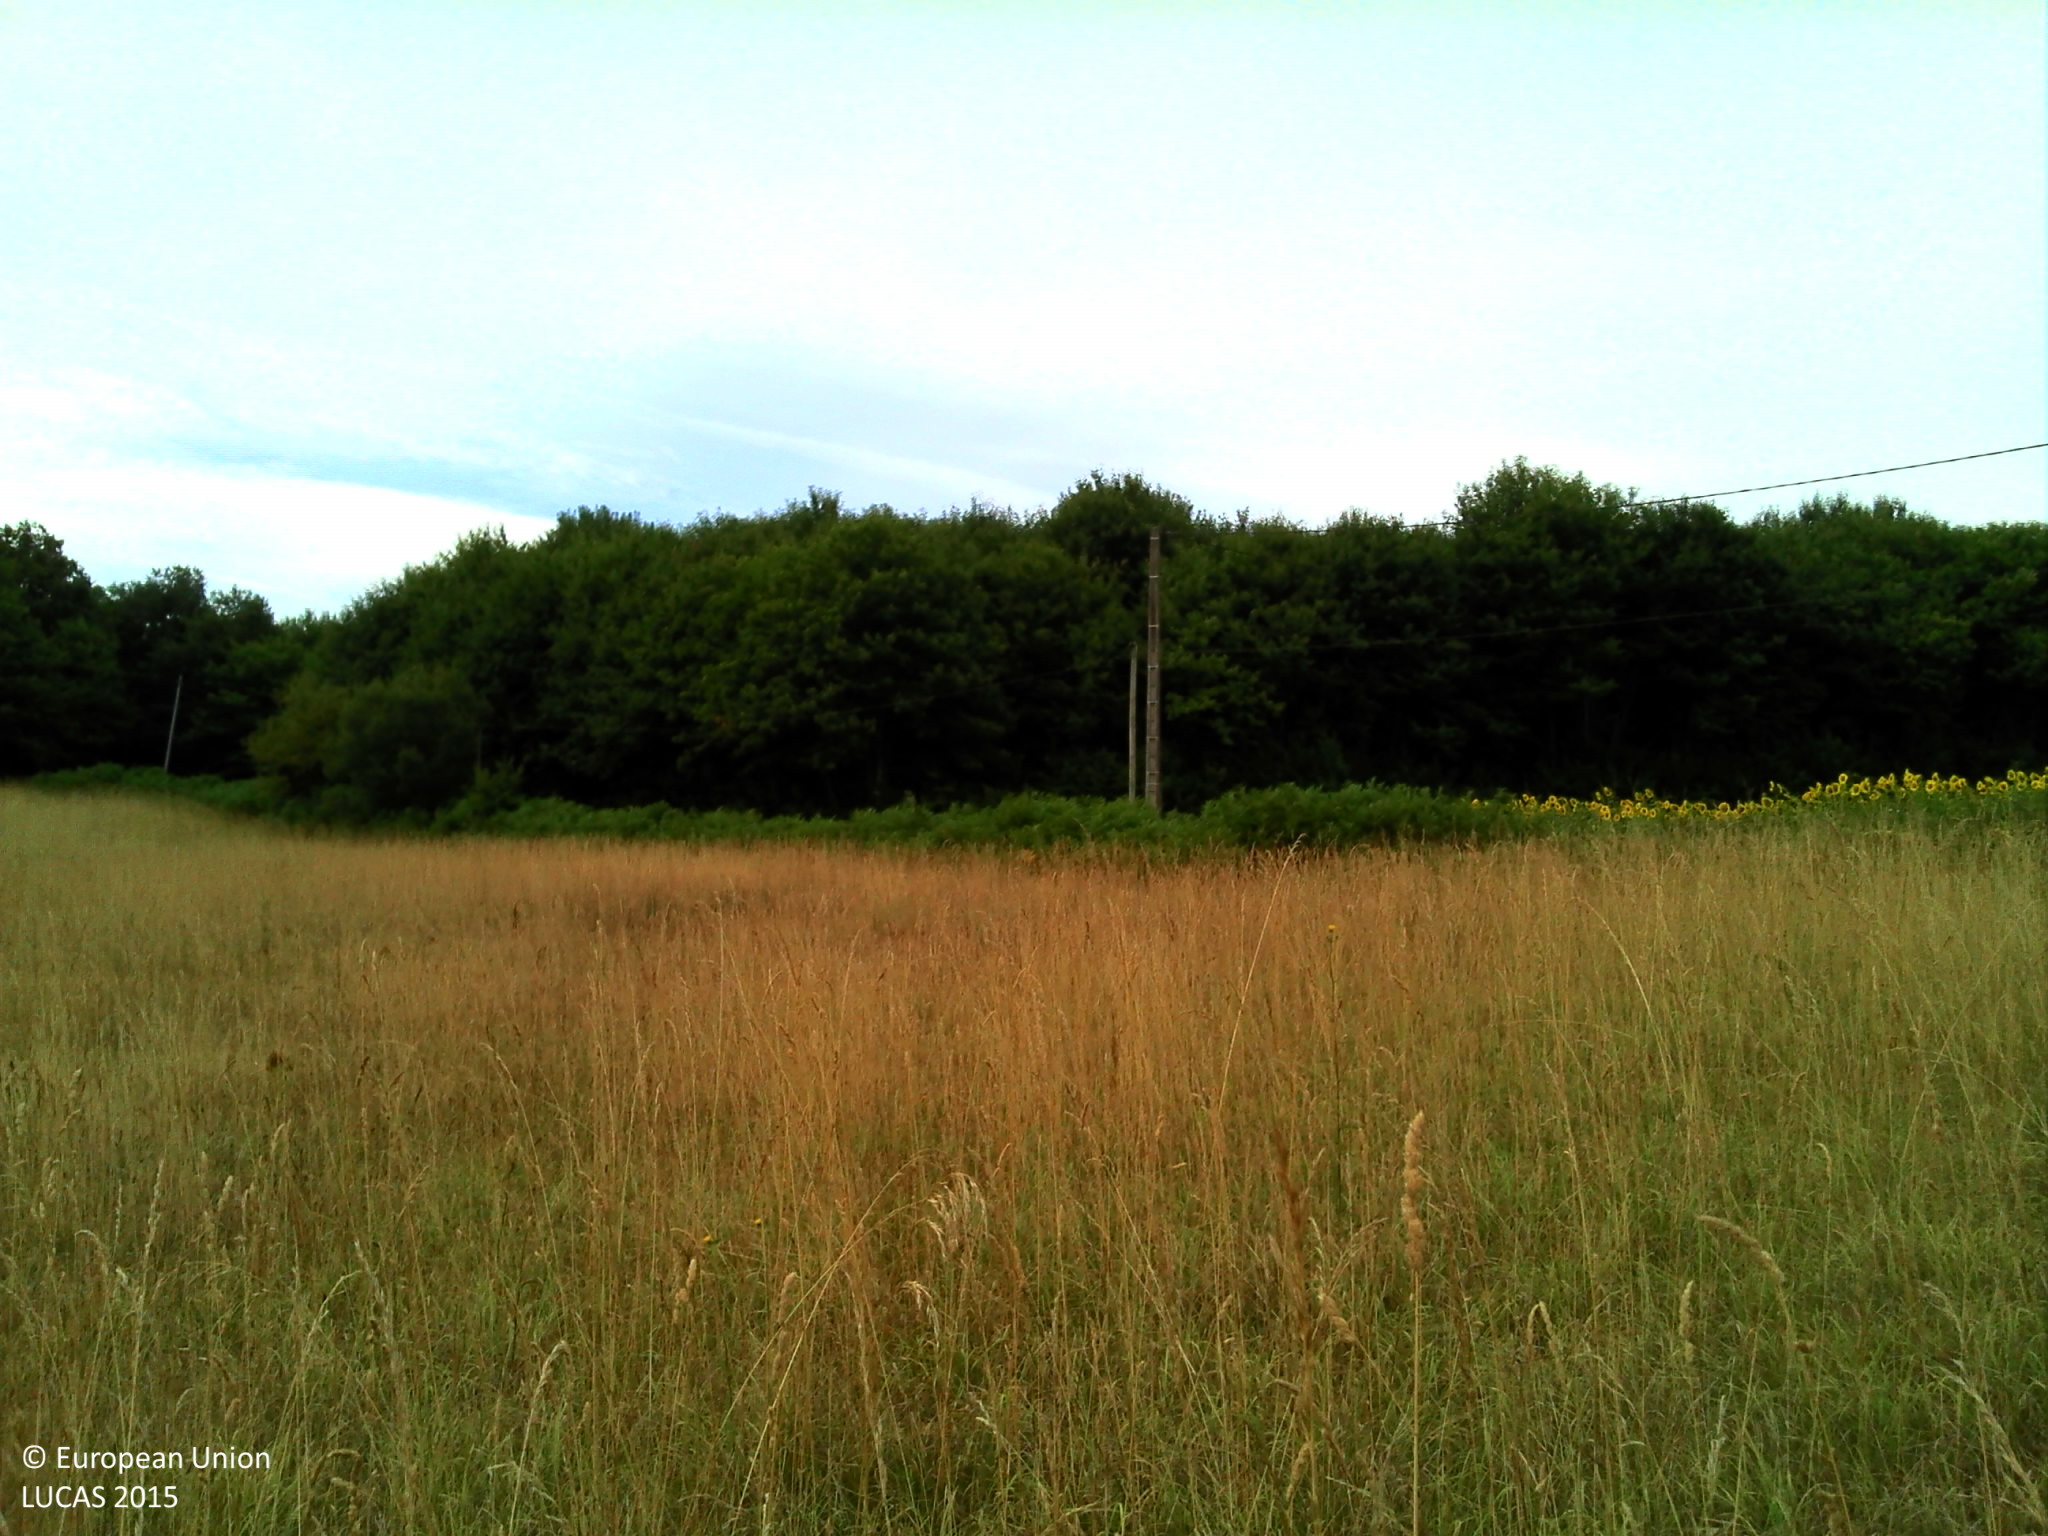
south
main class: Grassland
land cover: Grassland without tree/shrub cover
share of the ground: > 75 %
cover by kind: herbaceous plants 100 %
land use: Agriculture (excluding fallow land and kitchen gardens)
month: July
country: FR
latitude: 44.9771
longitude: 0.8236
